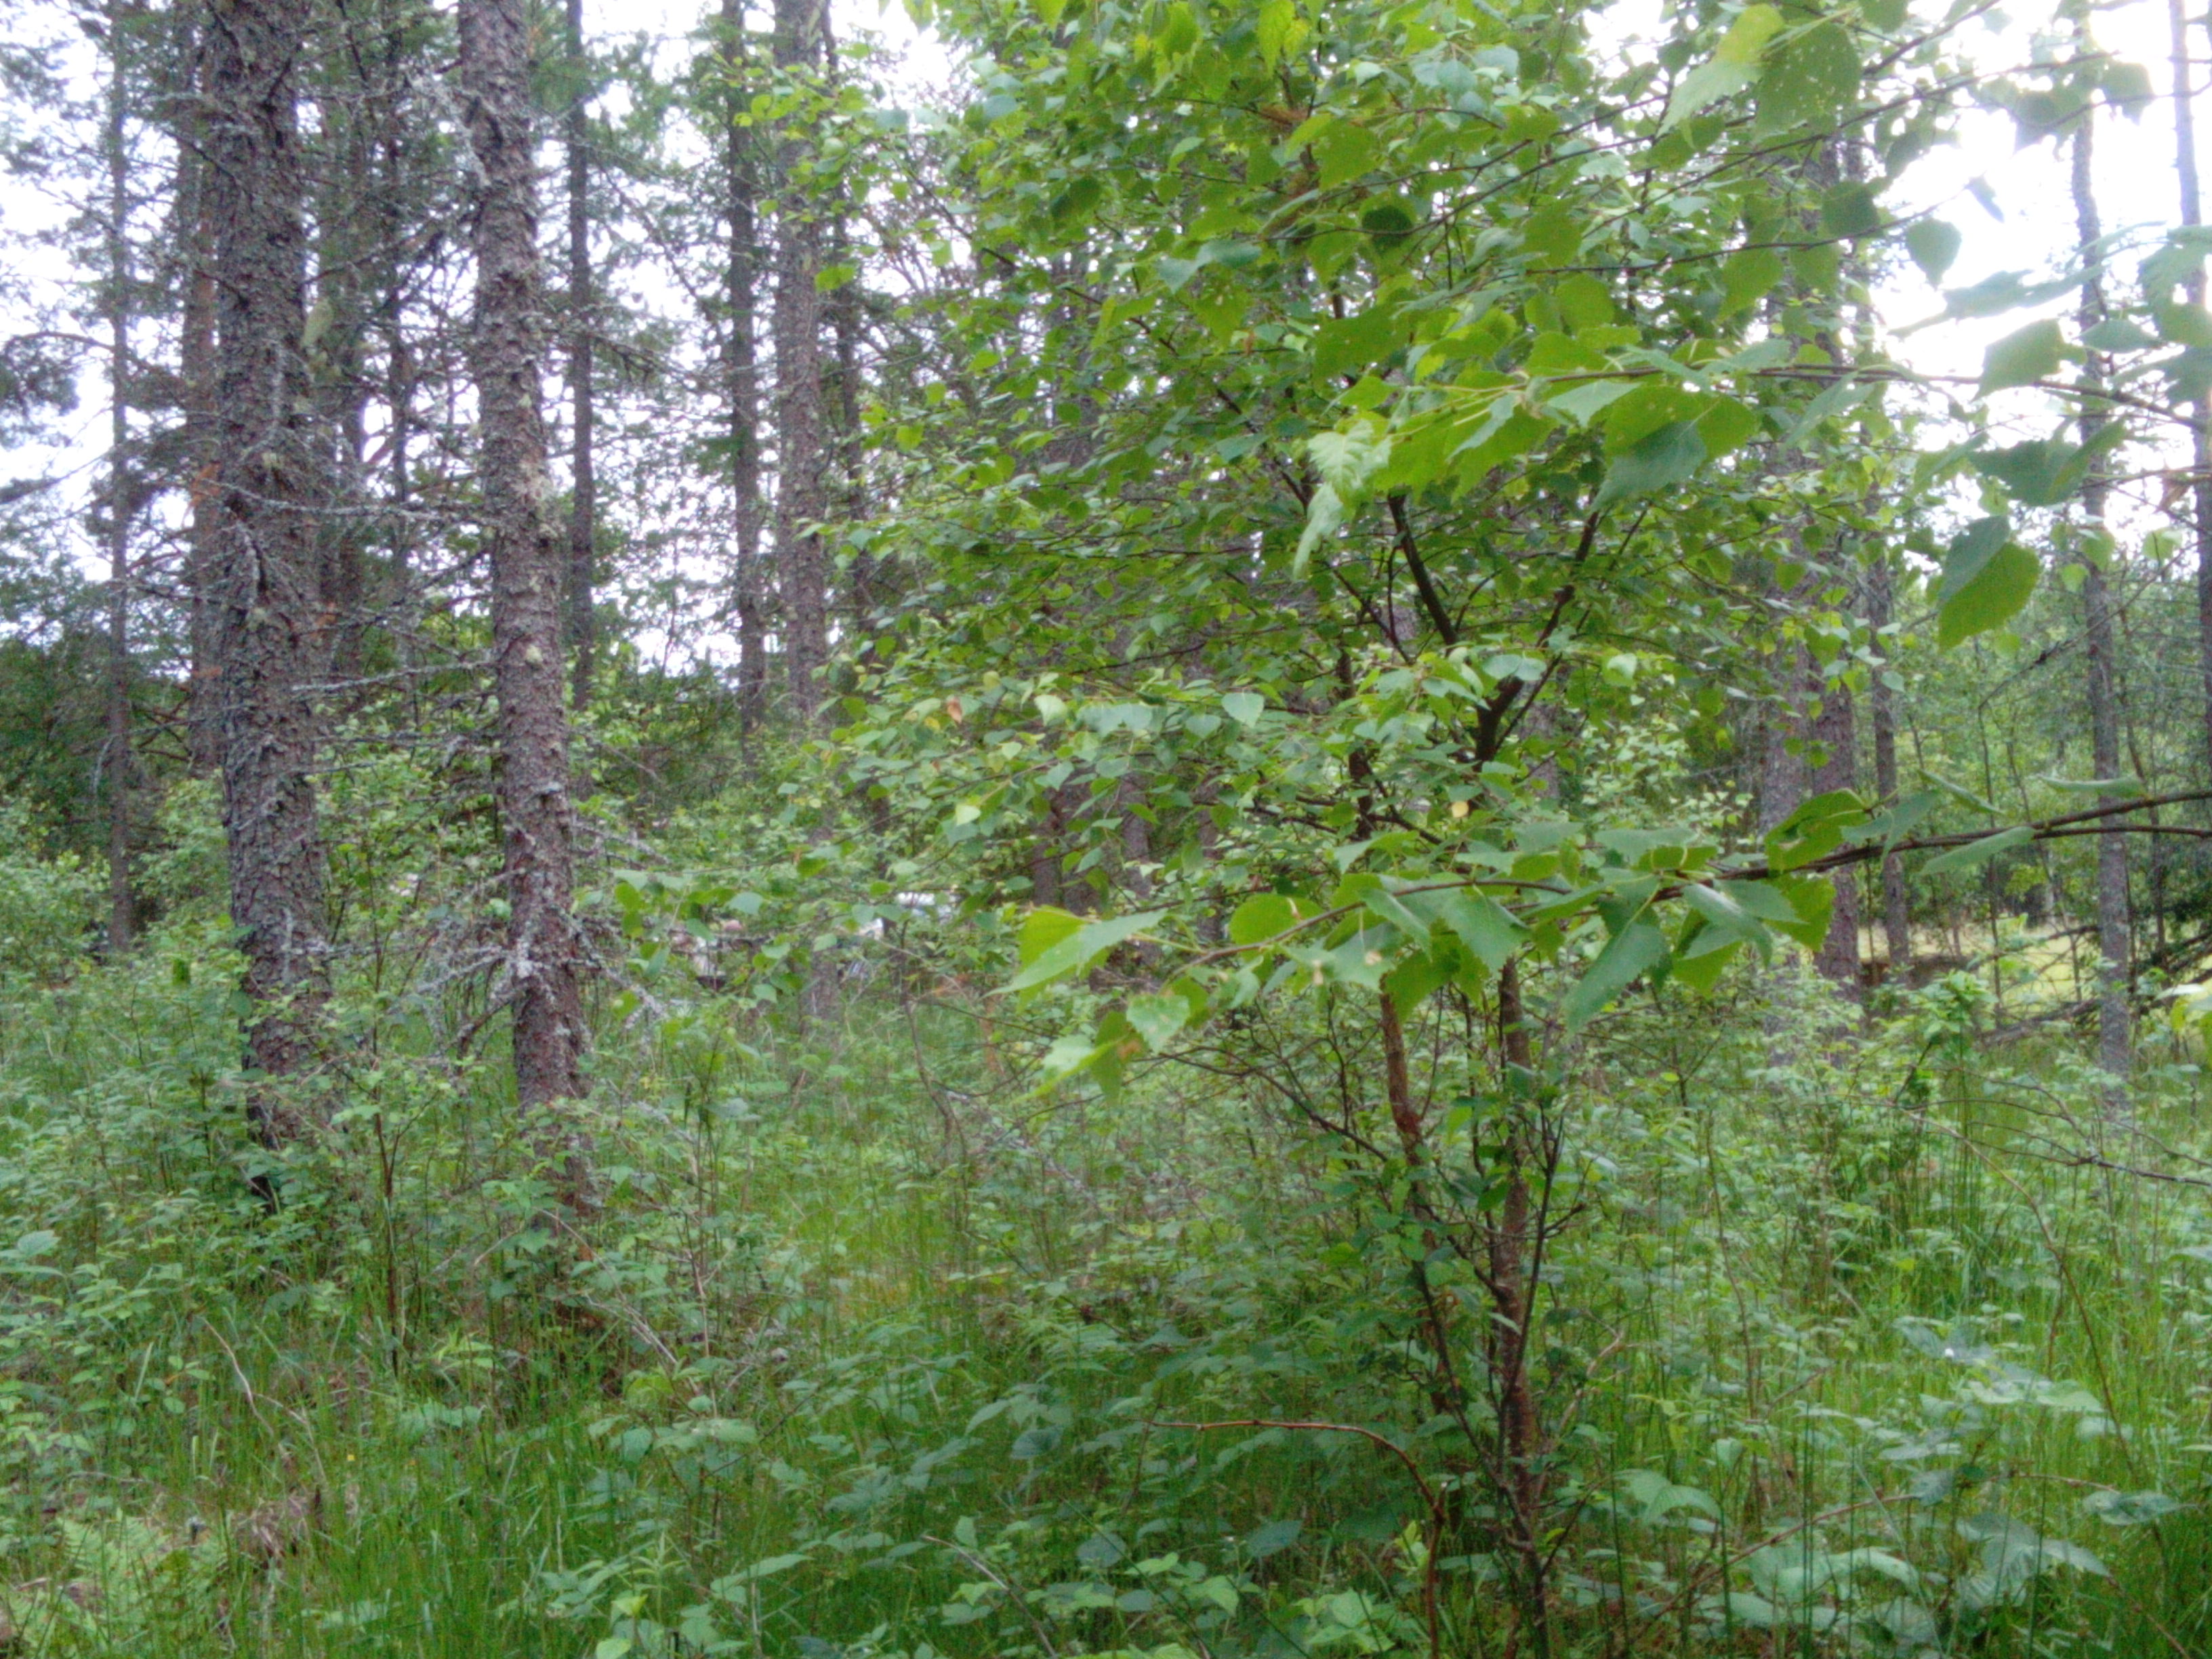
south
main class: Woodland
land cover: Spruce dominated mixed woodland
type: hemiboreal forest and nemoral coniferous forest and mixed broadleaved-coniferous forest
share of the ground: 50 - 75 %
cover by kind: broadleaved forest trees 45 %, coniferous forest trees 25 %, herbaceous plants 20 %, shrubs 10 %
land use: Forestry
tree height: > 5 m
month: June
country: LV
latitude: 56.9774
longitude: 21.5080
